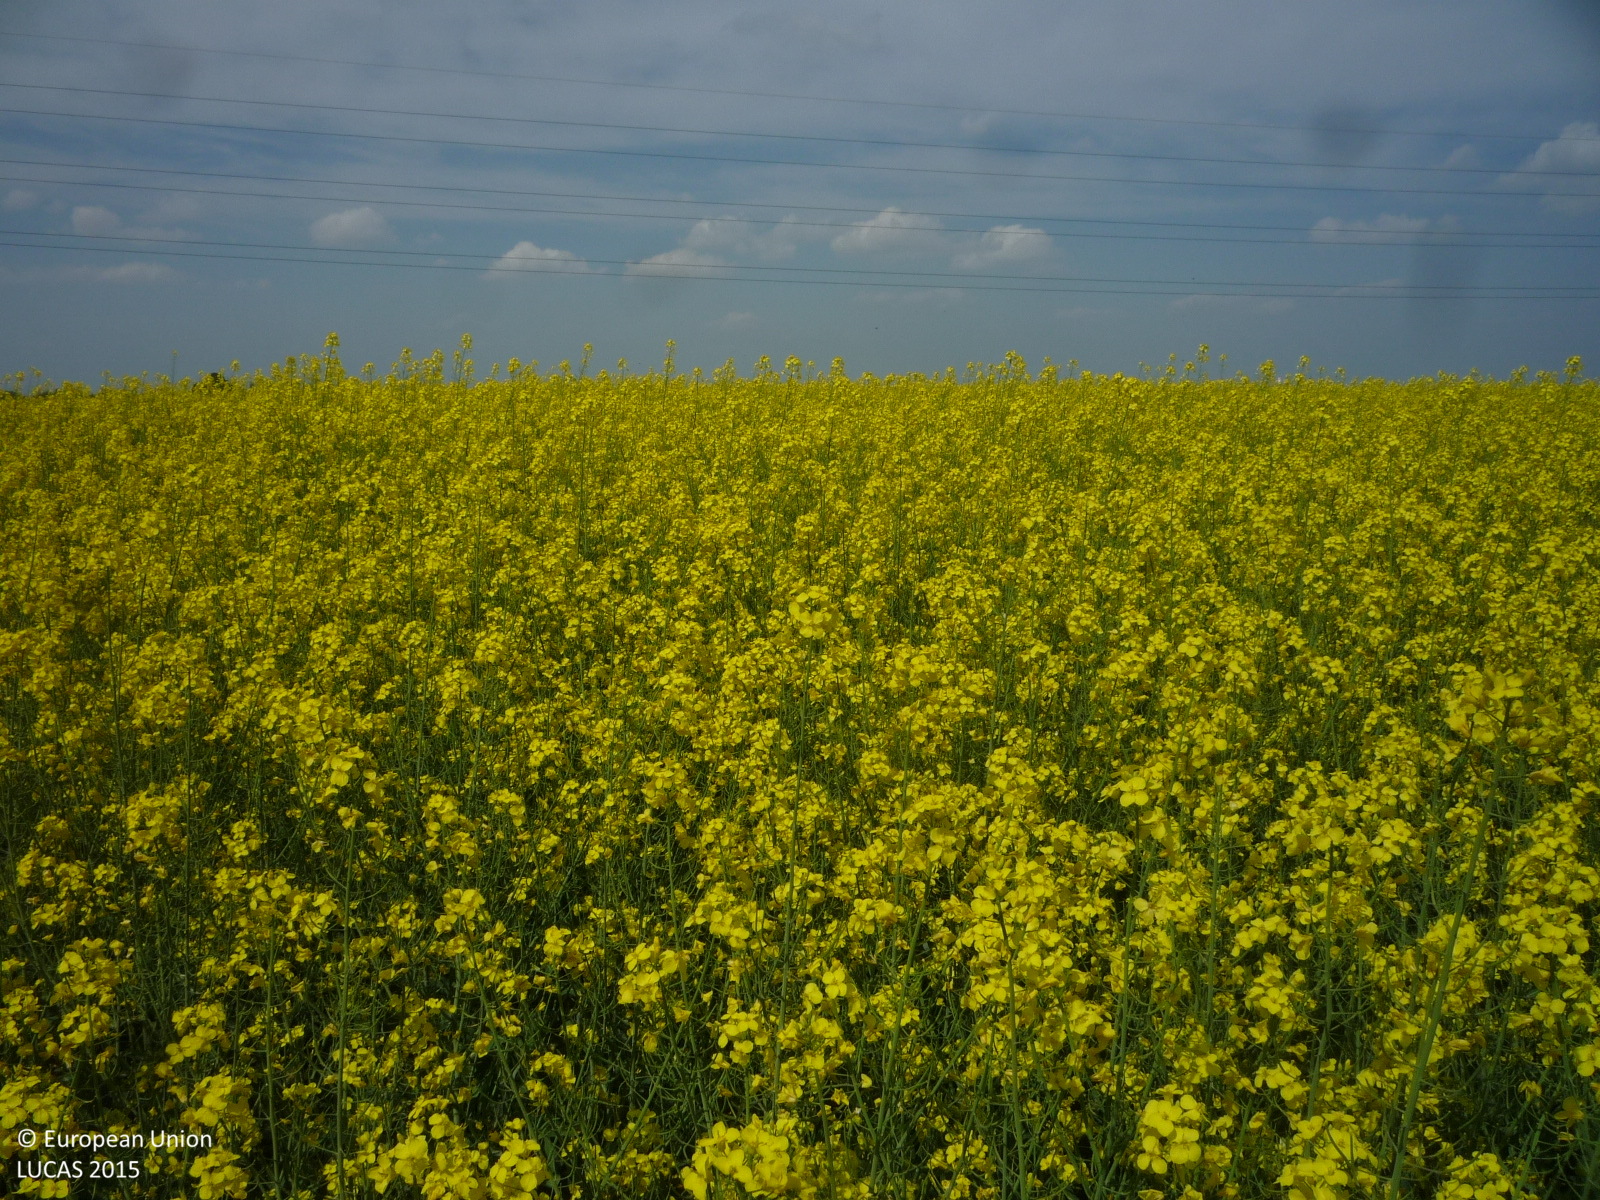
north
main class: Cropland
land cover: Rape and turnip rape
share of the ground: > 75 %
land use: Agriculture (excluding fallow land and kitchen gardens)
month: May
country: CZ
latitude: 50.1598
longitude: 14.6913
